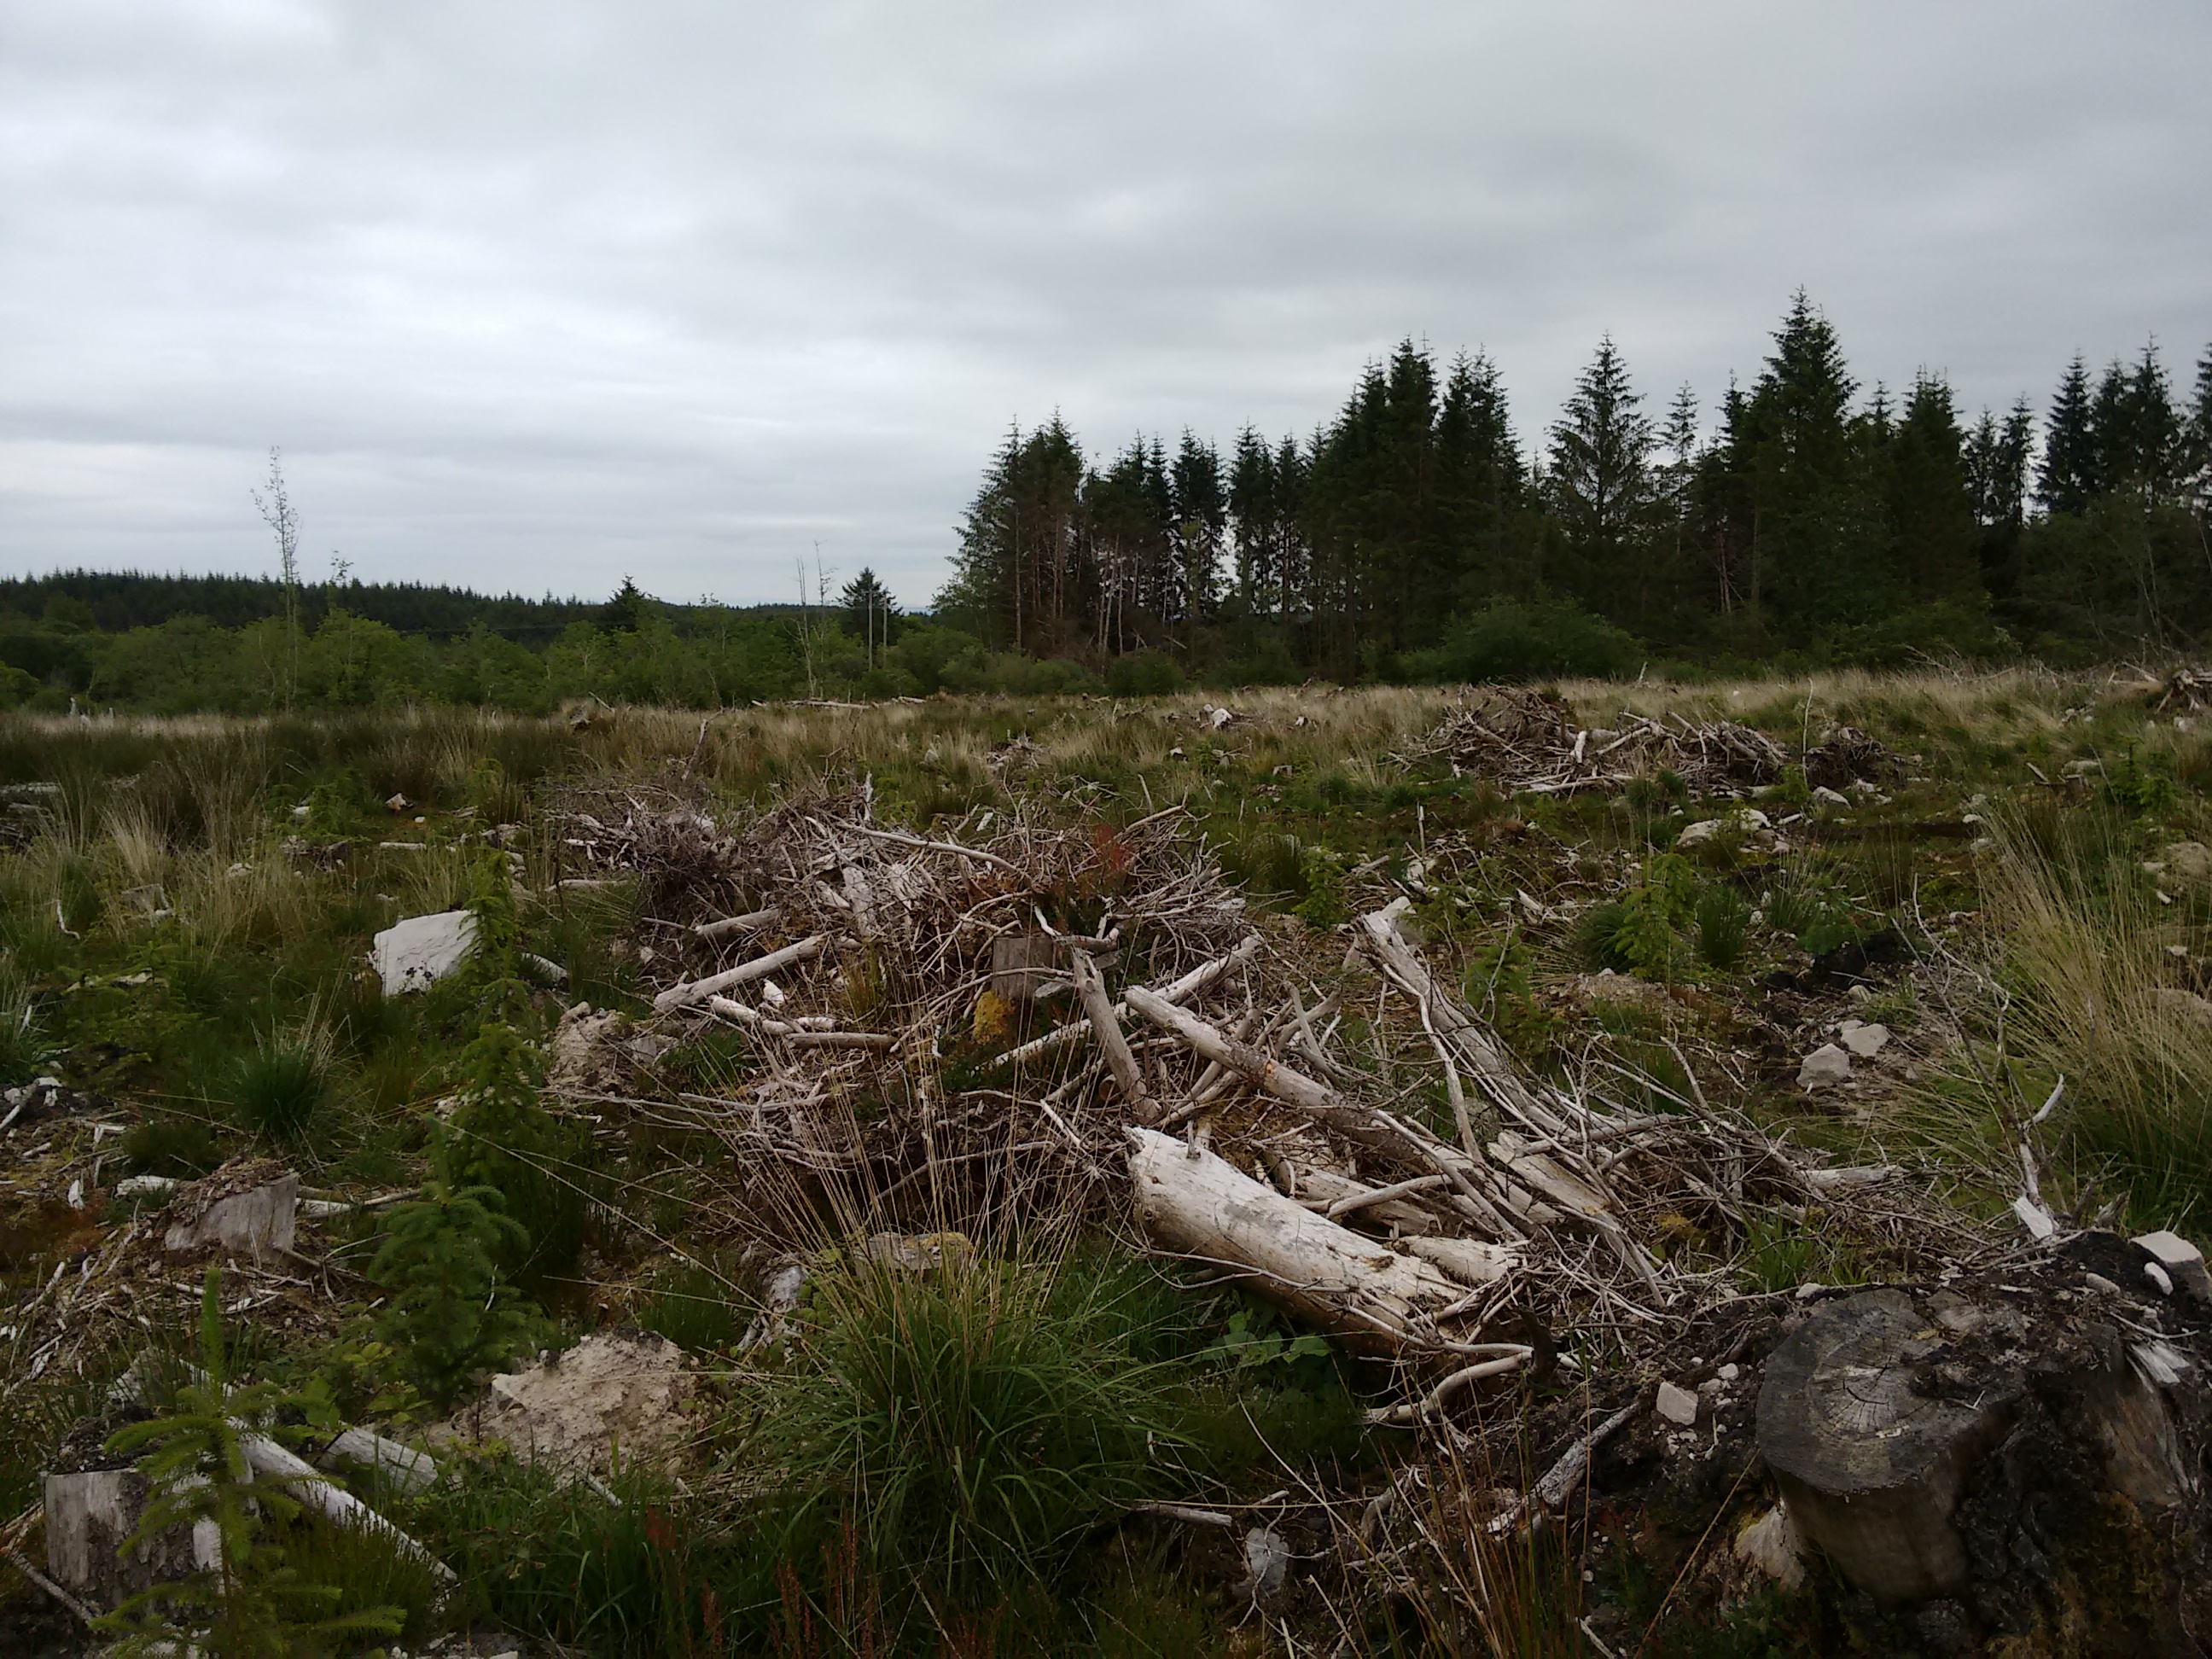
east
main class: Grassland
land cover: Grassland with sparse tree/shrub cover
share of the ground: > 75 %
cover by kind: herbaceous plants 35 %, lichens and mosses 10 %, broadleaved forest trees 5 %, shrubs 5 %
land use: Forestry
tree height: < 5 m
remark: Clear cut
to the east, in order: Grassland with sparse tree/shrub cover; Broadleaved woodland; Dry stone walls; Ditches and canals; Grass margins; Paved roads, cycling and walking lanes; Broadleaved woodland; Ditches and canals; Dry stone walls; Fences; Broadleaved woodland; Shrubland without tree cover; Single bushes/trees; Electric lines; Shrubland without tree cover
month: June
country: IE
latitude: 53.0483
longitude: -8.4971
